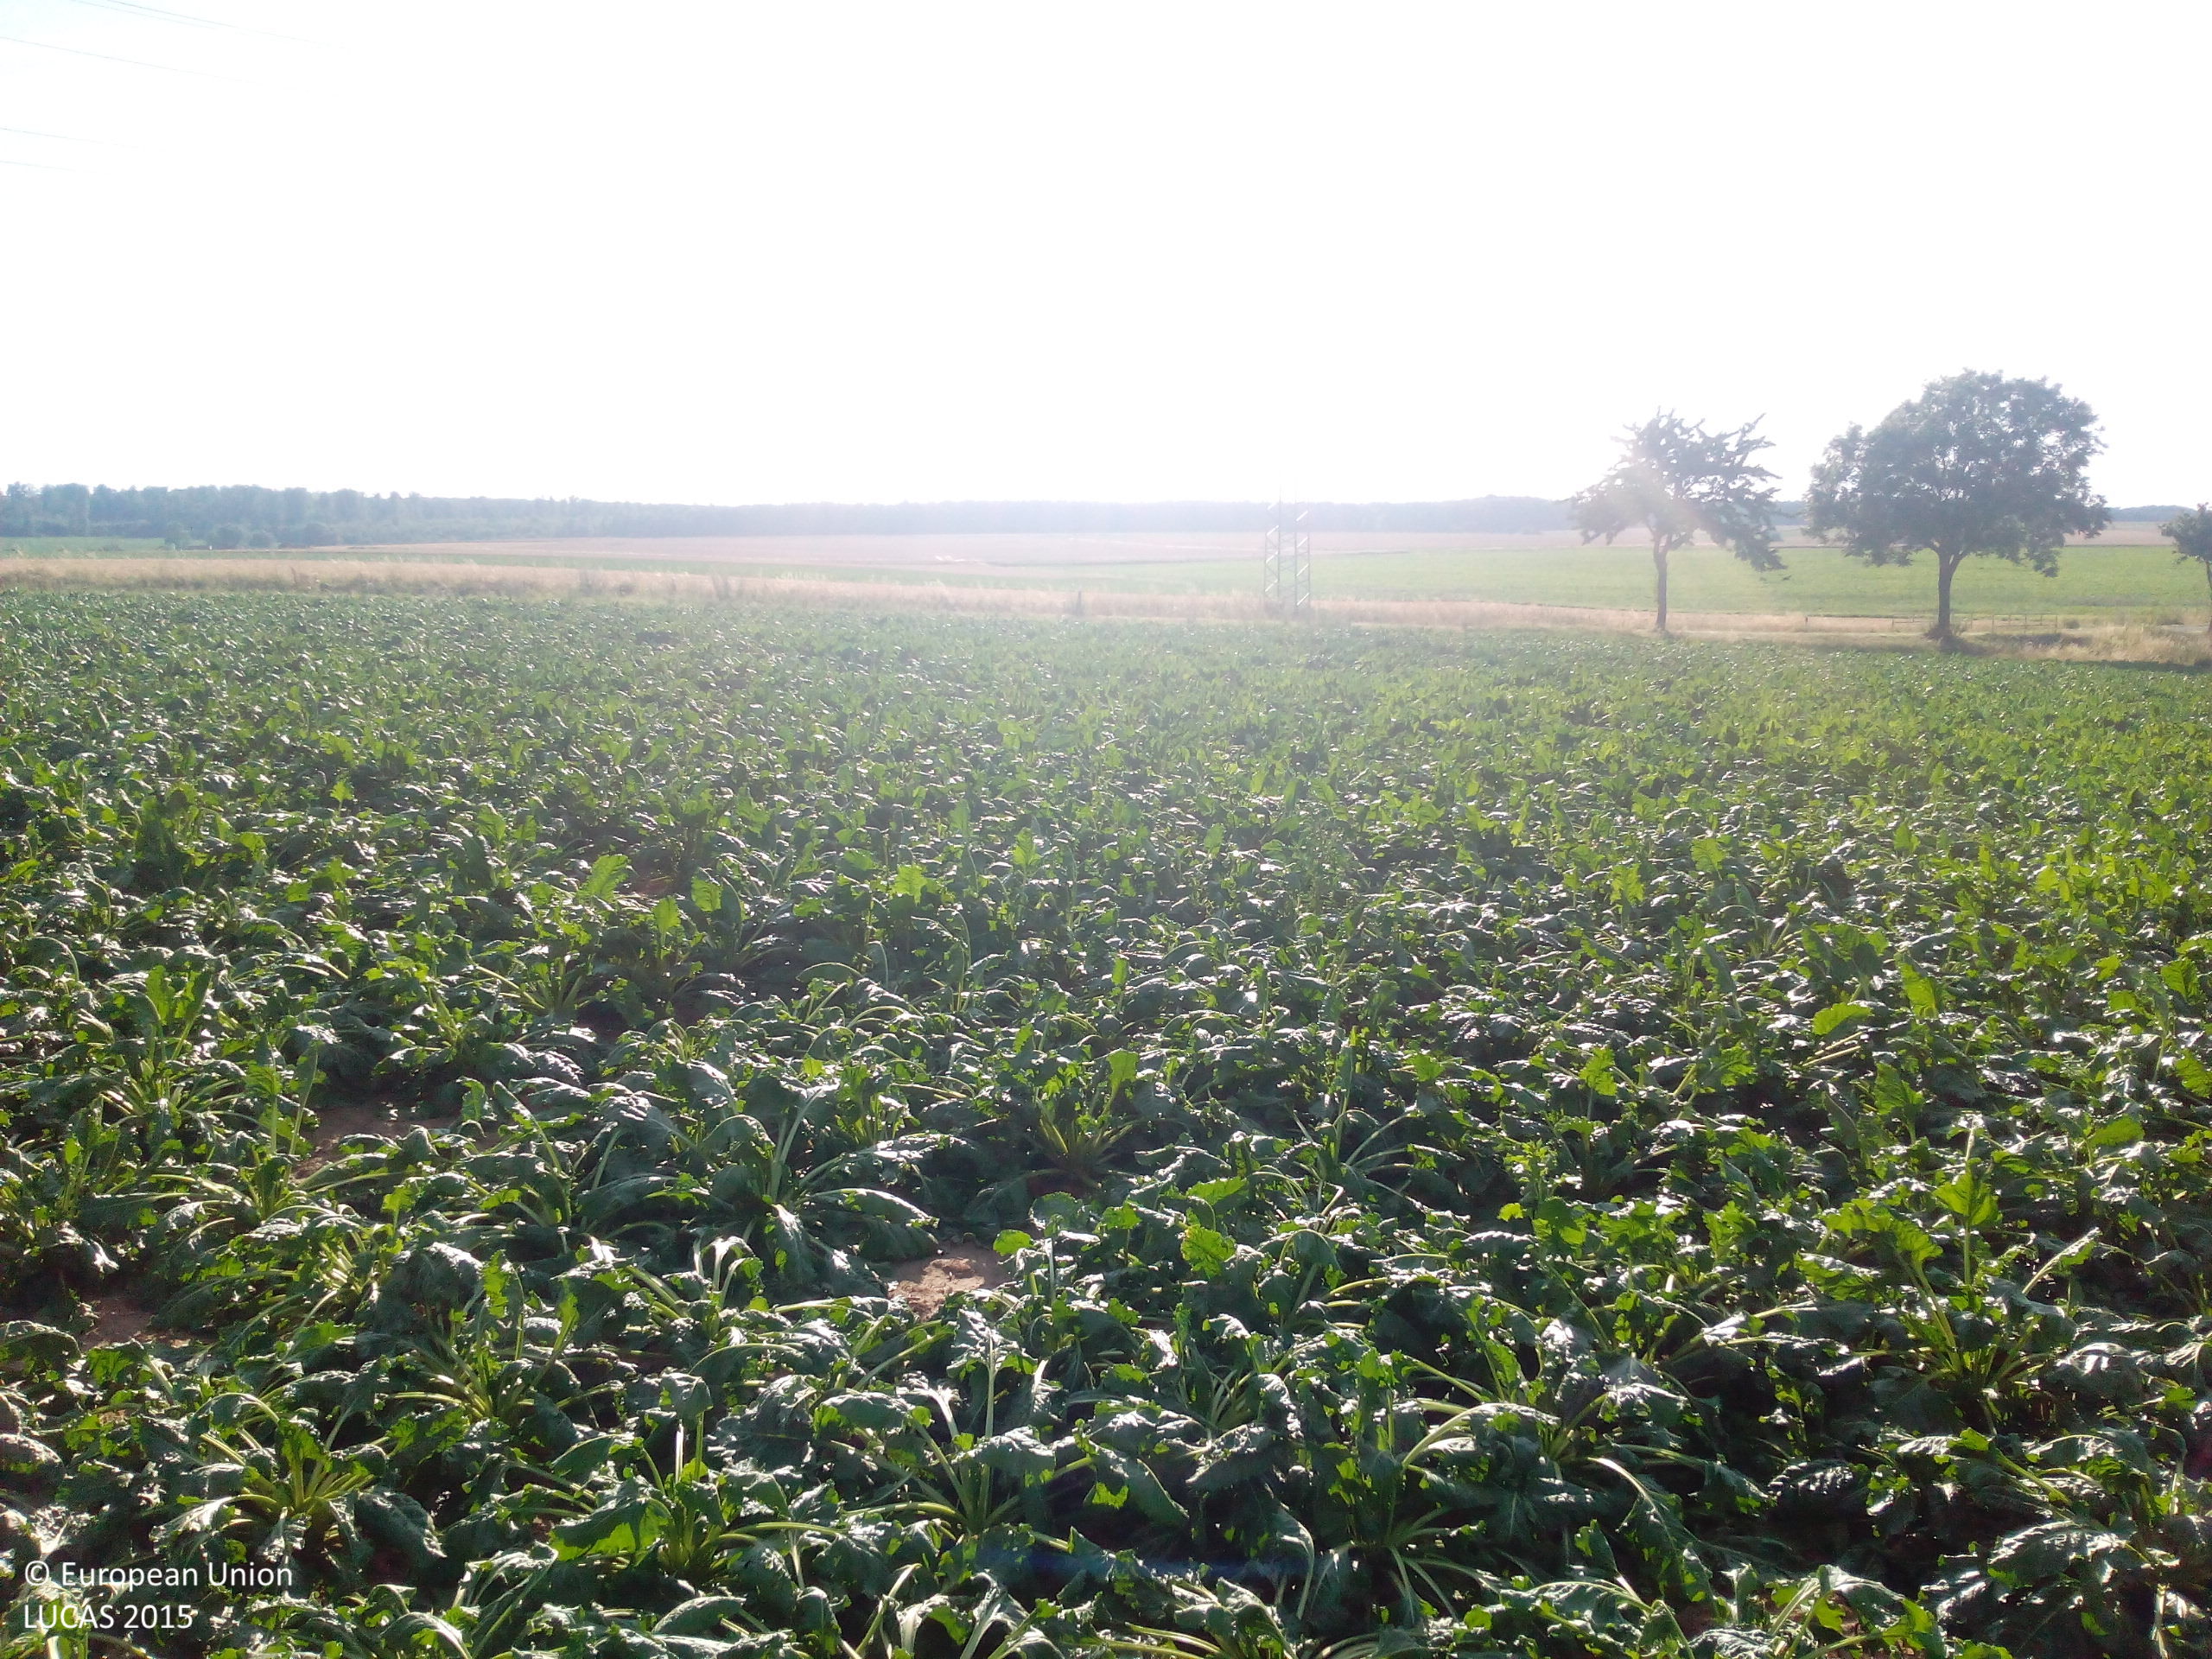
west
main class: Cropland
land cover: Sugar beet
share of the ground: > 75 %
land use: Agriculture (excluding fallow land and kitchen gardens)
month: August
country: DE
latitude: 52.2126
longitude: 10.8632
